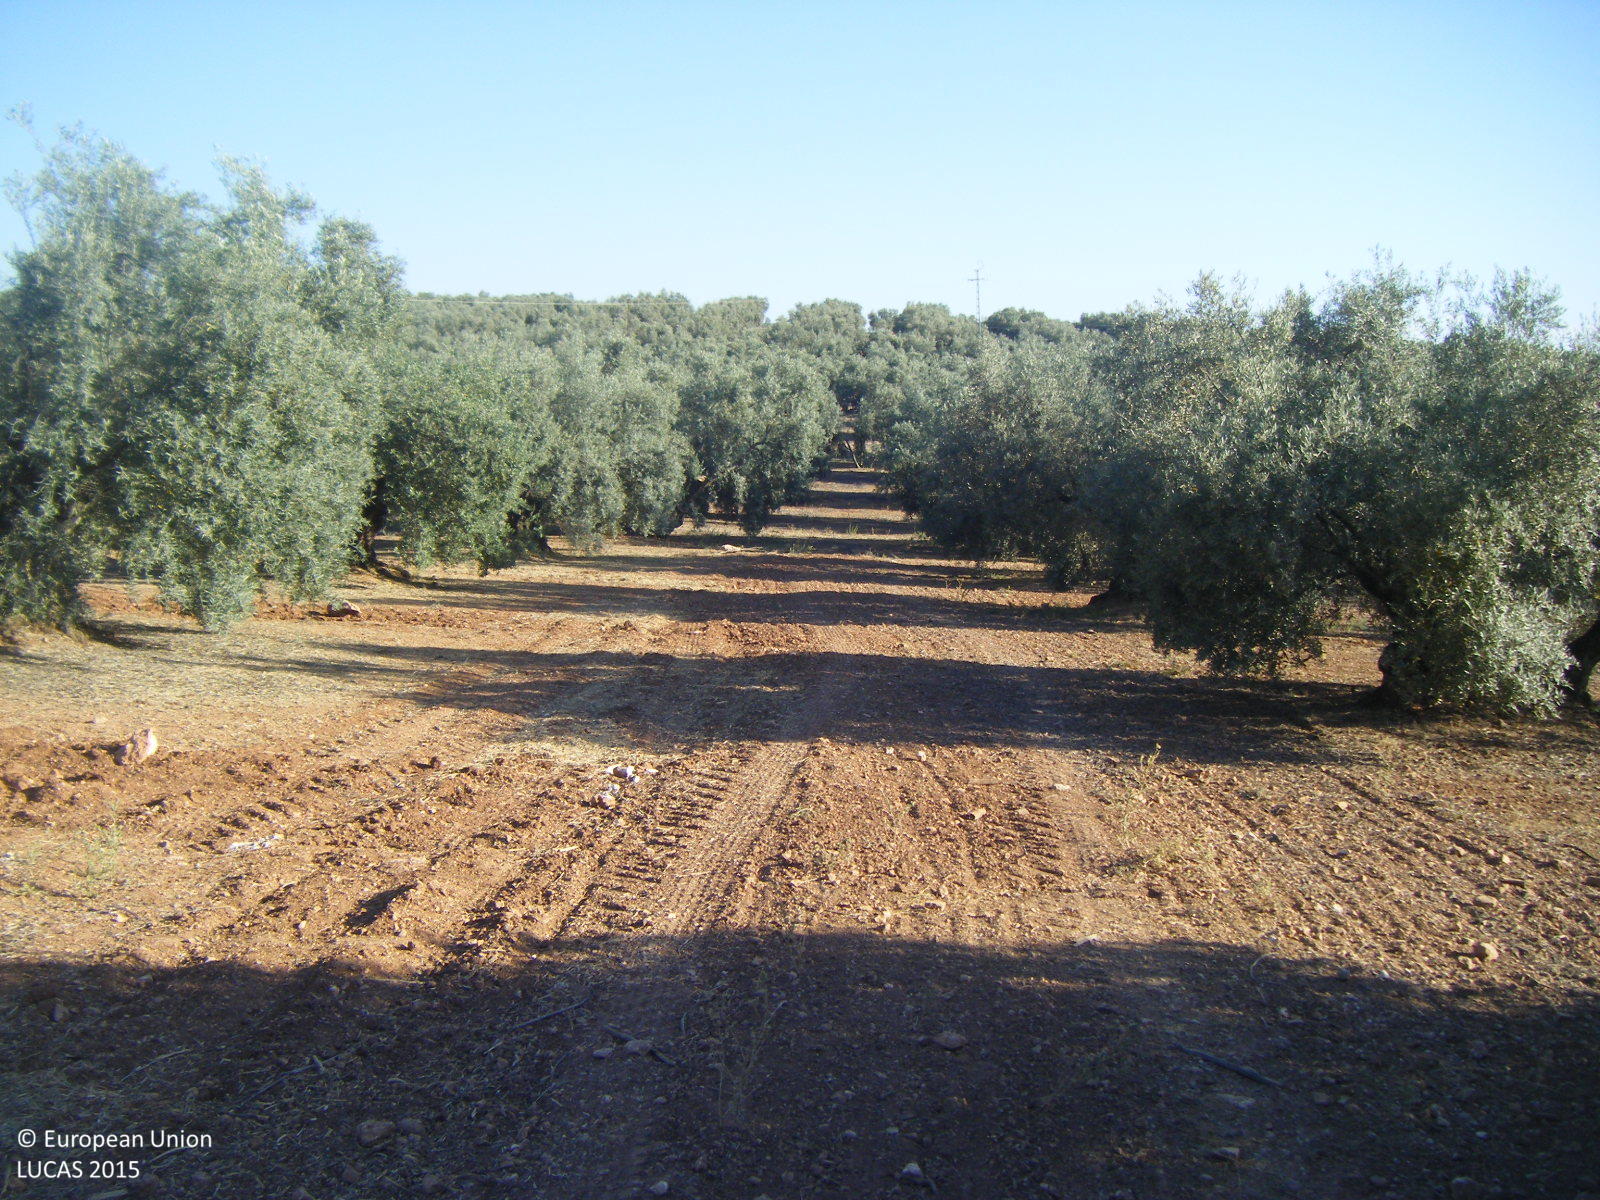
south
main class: Cropland
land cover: Olive groves
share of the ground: 25 - 50 %
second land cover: Other bare soil
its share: > 75 %
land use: Agriculture (excluding fallow land and kitchen gardens)
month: June
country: ES
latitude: 37.2993
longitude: -4.4518
